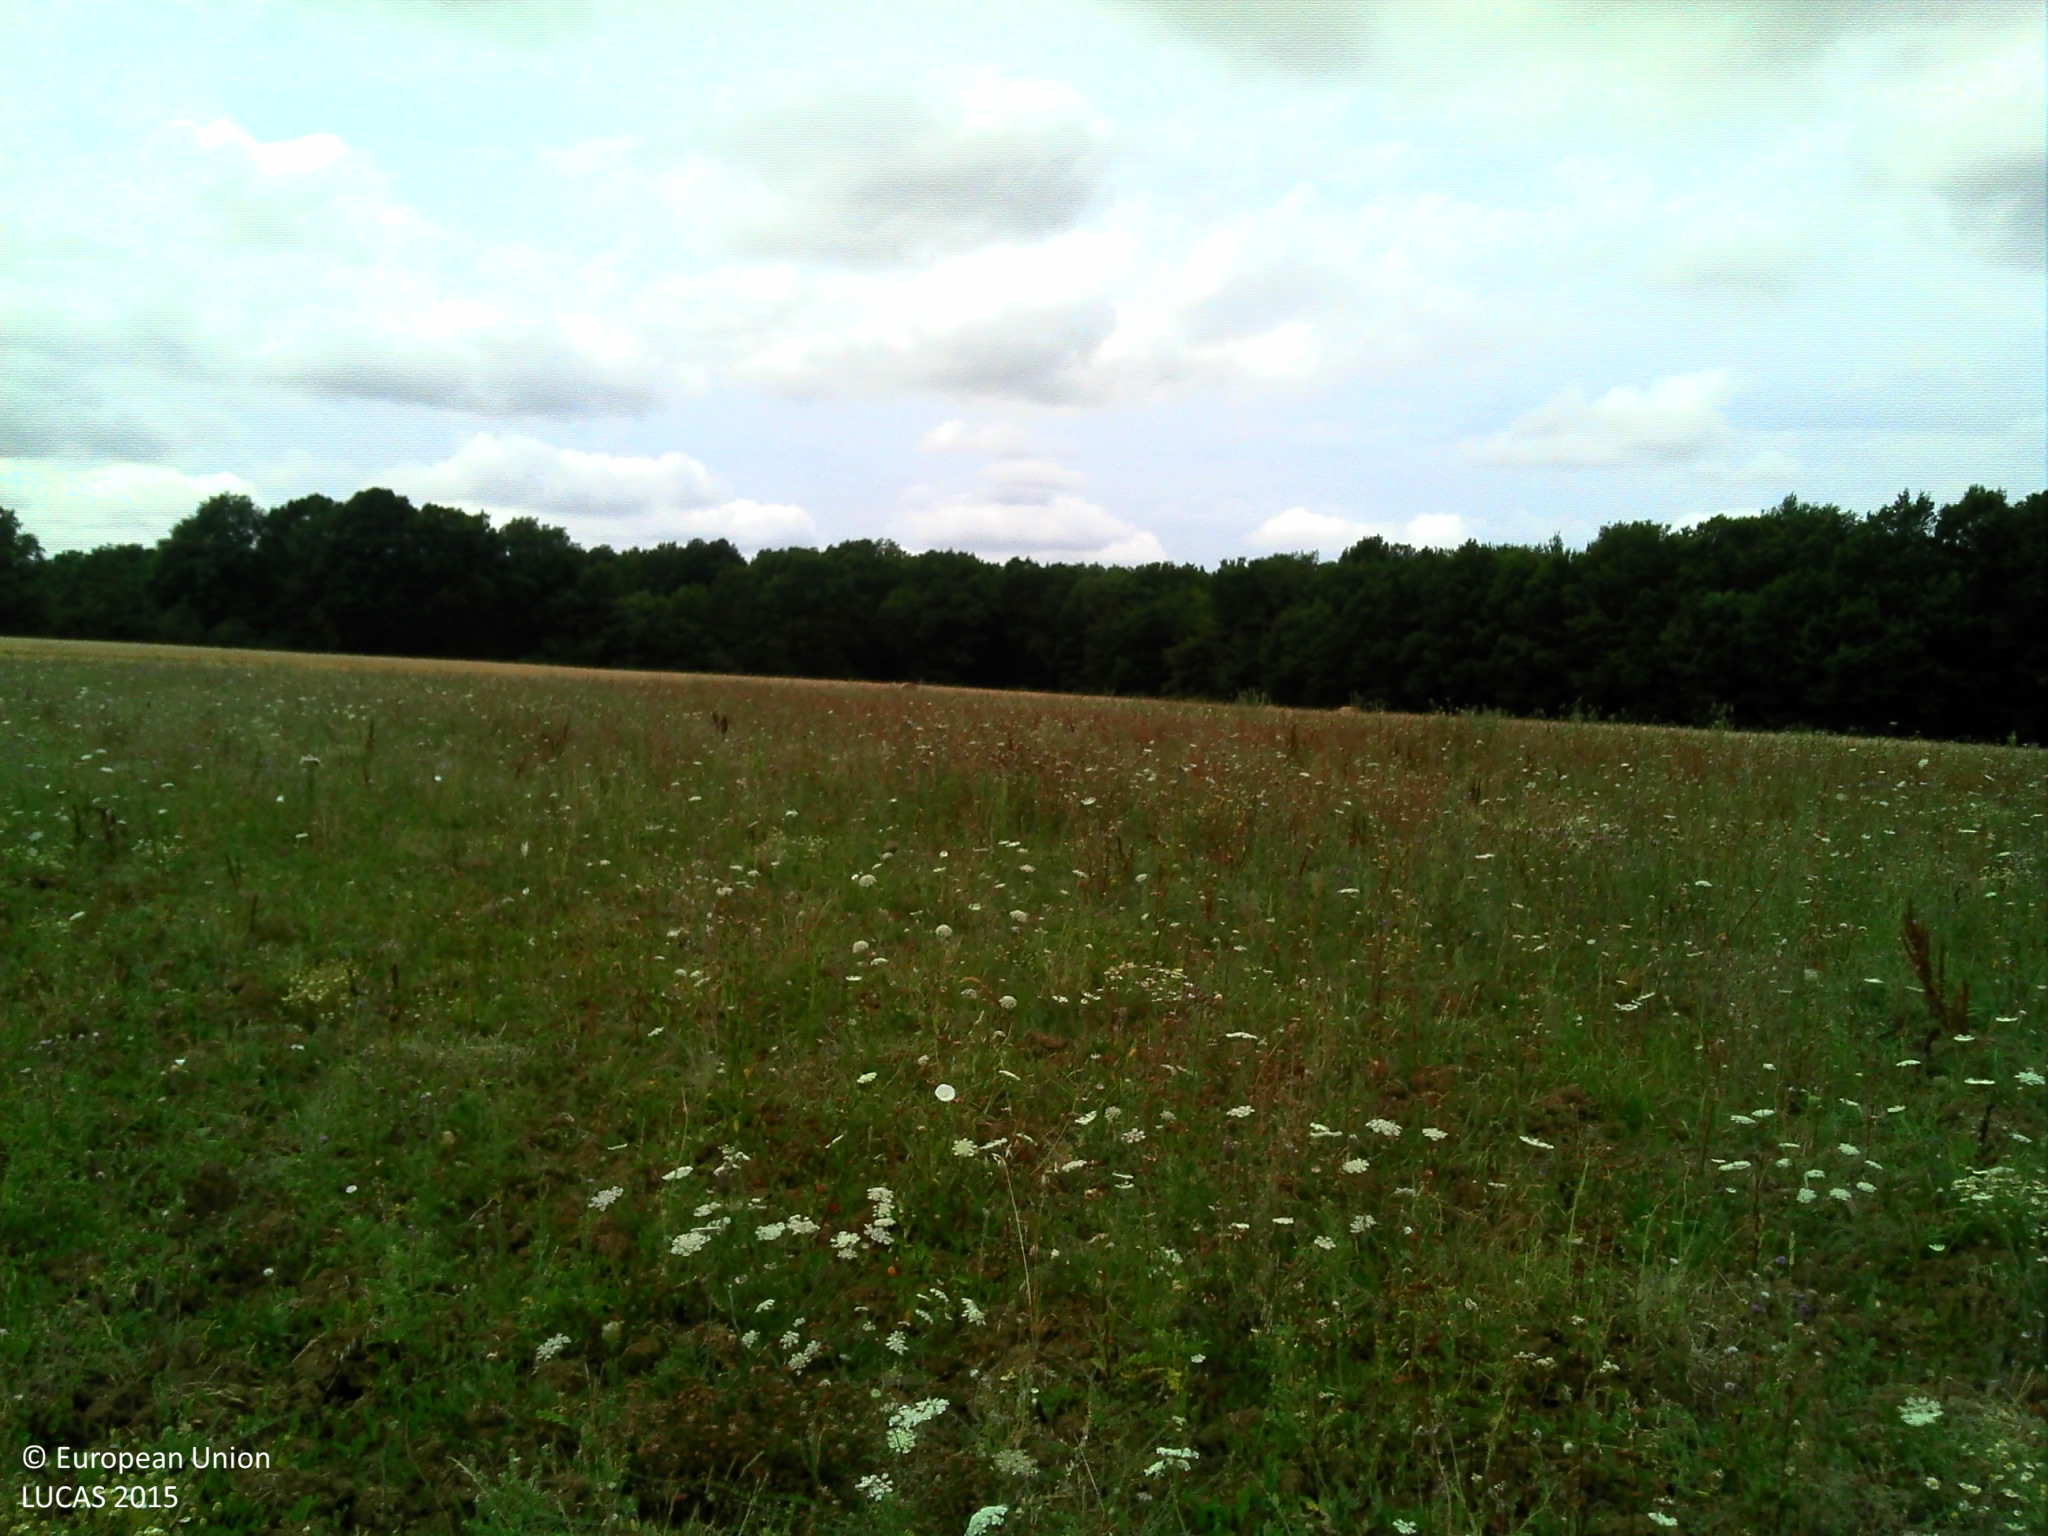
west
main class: Grassland
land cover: Spontaneously vegetated surfaces
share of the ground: > 75 %
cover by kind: herbaceous plants 100 %
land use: Fallow land
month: July
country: FR
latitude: 46.6626
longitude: 2.9784
